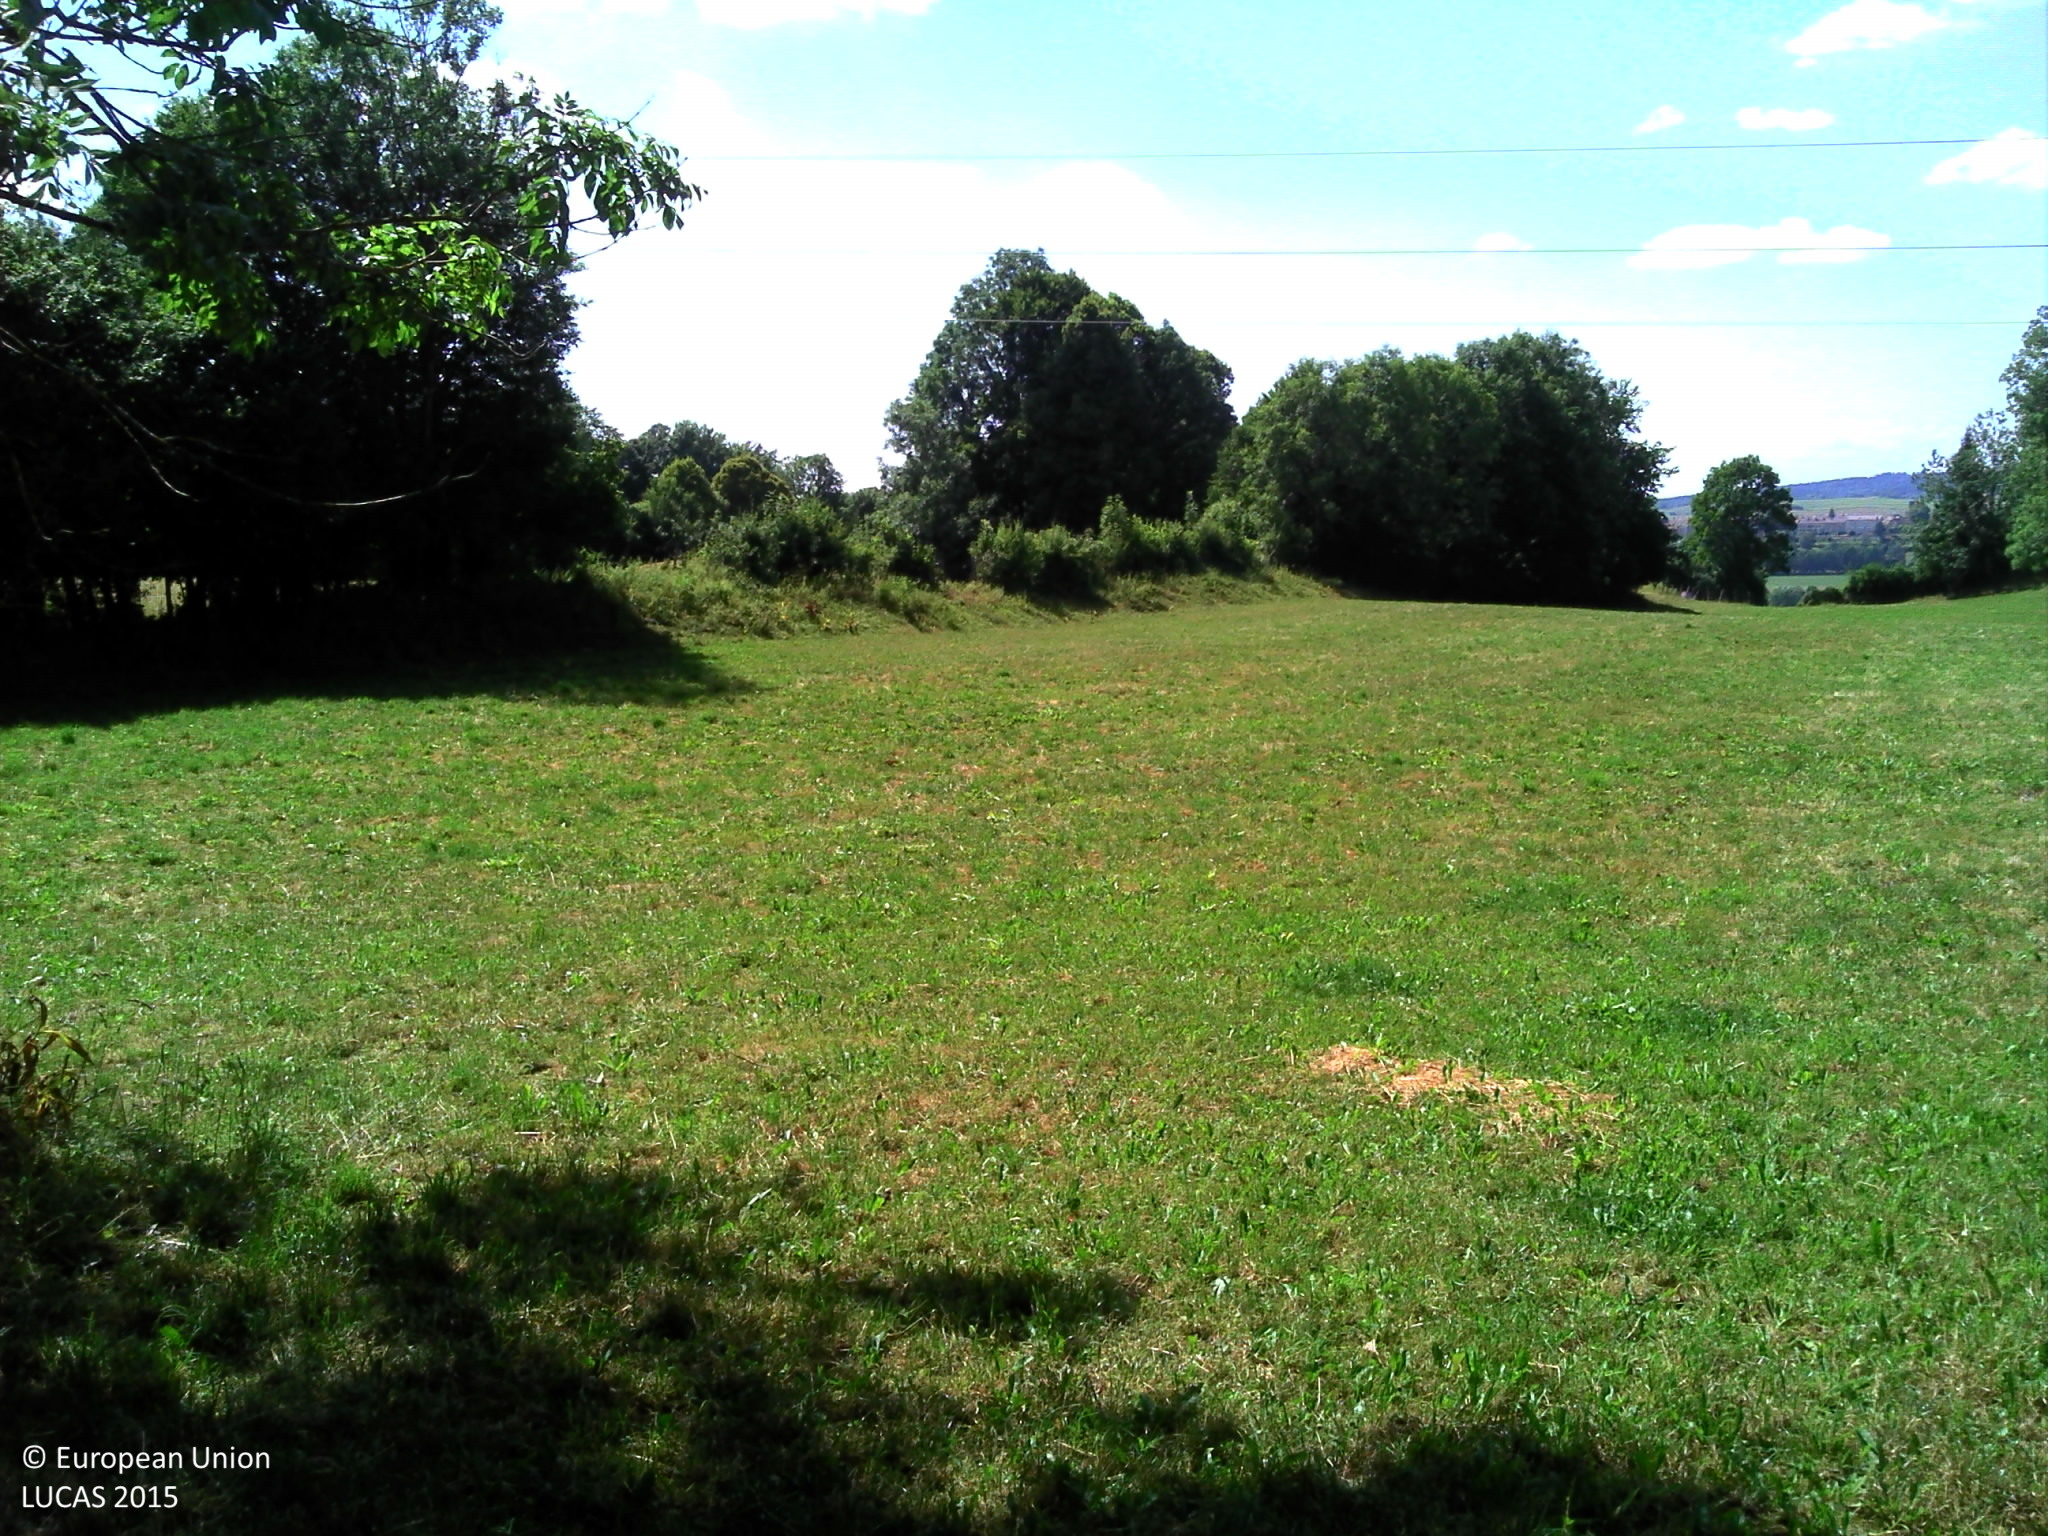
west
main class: Grassland
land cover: Grassland without tree/shrub cover
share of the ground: > 75 %
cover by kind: herbaceous plants 100 %
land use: Agriculture (excluding fallow land and kitchen gardens)
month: July
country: FR
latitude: 46.7655
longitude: 6.0612
